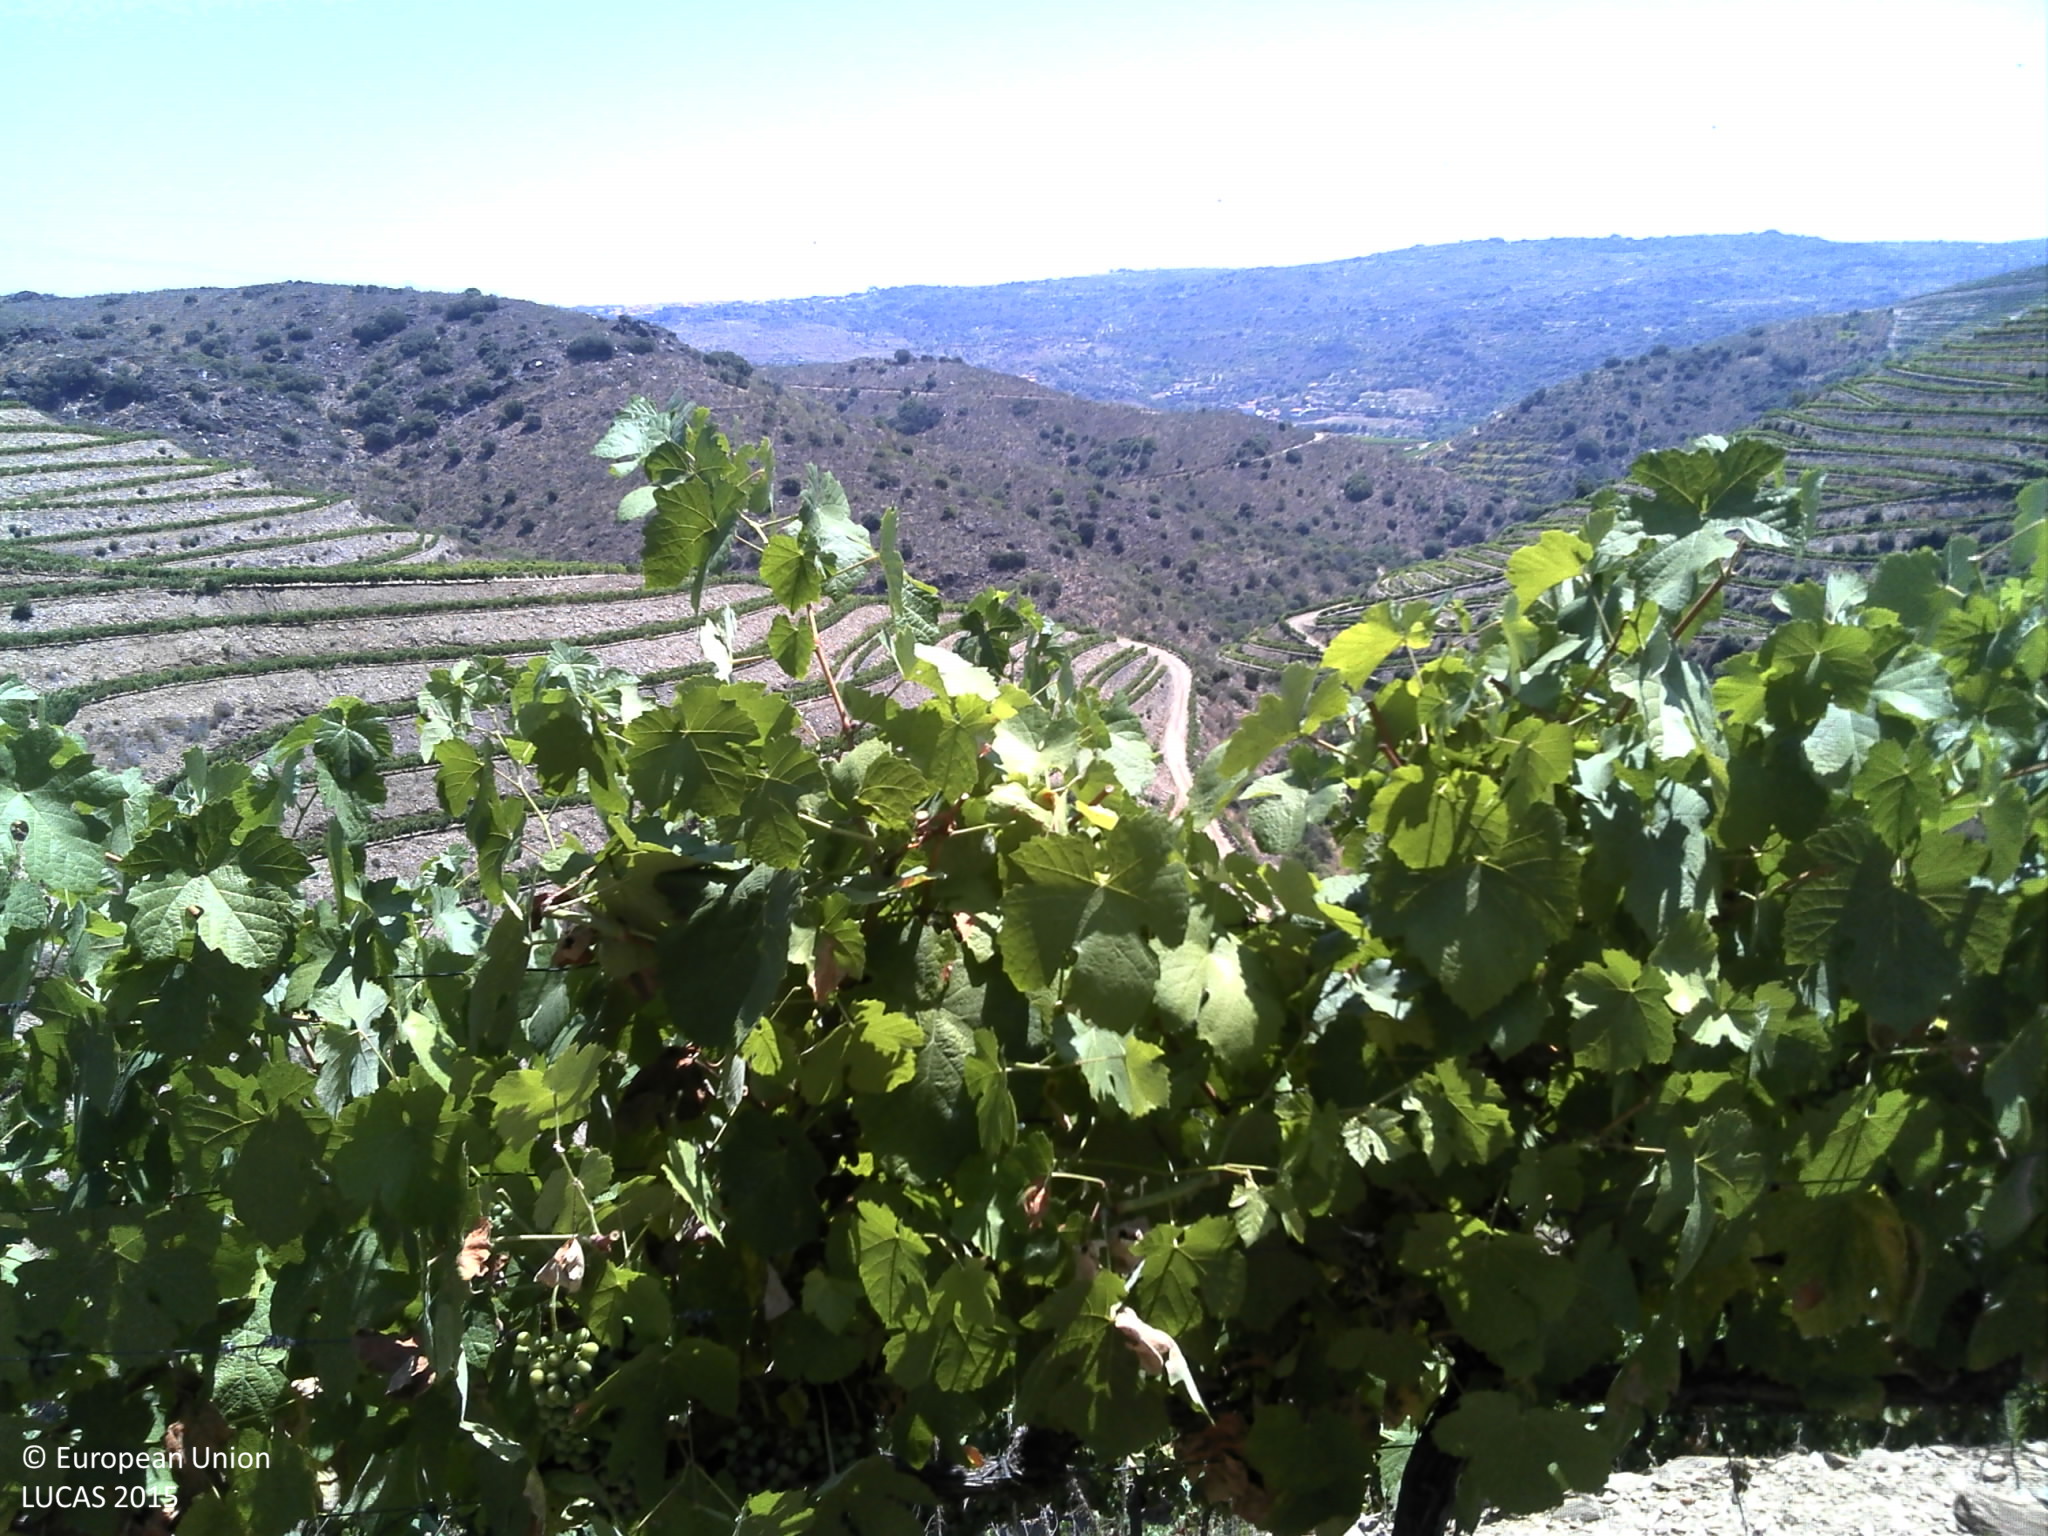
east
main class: Cropland
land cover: Vineyards
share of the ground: < 10 %
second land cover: Other bare soil
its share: > 75 %
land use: Agriculture (excluding fallow land and kitchen gardens)
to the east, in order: Vineyards; Other bare soil; Vineyards; Tracks; Single bushes/trees; Ditches and canals; Tracks; Broadleaved woodland; Tracks; Ditches and canals; Broadleaved woodland; Vineyards
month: July
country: PT
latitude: 40.9827
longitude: -7.2149
